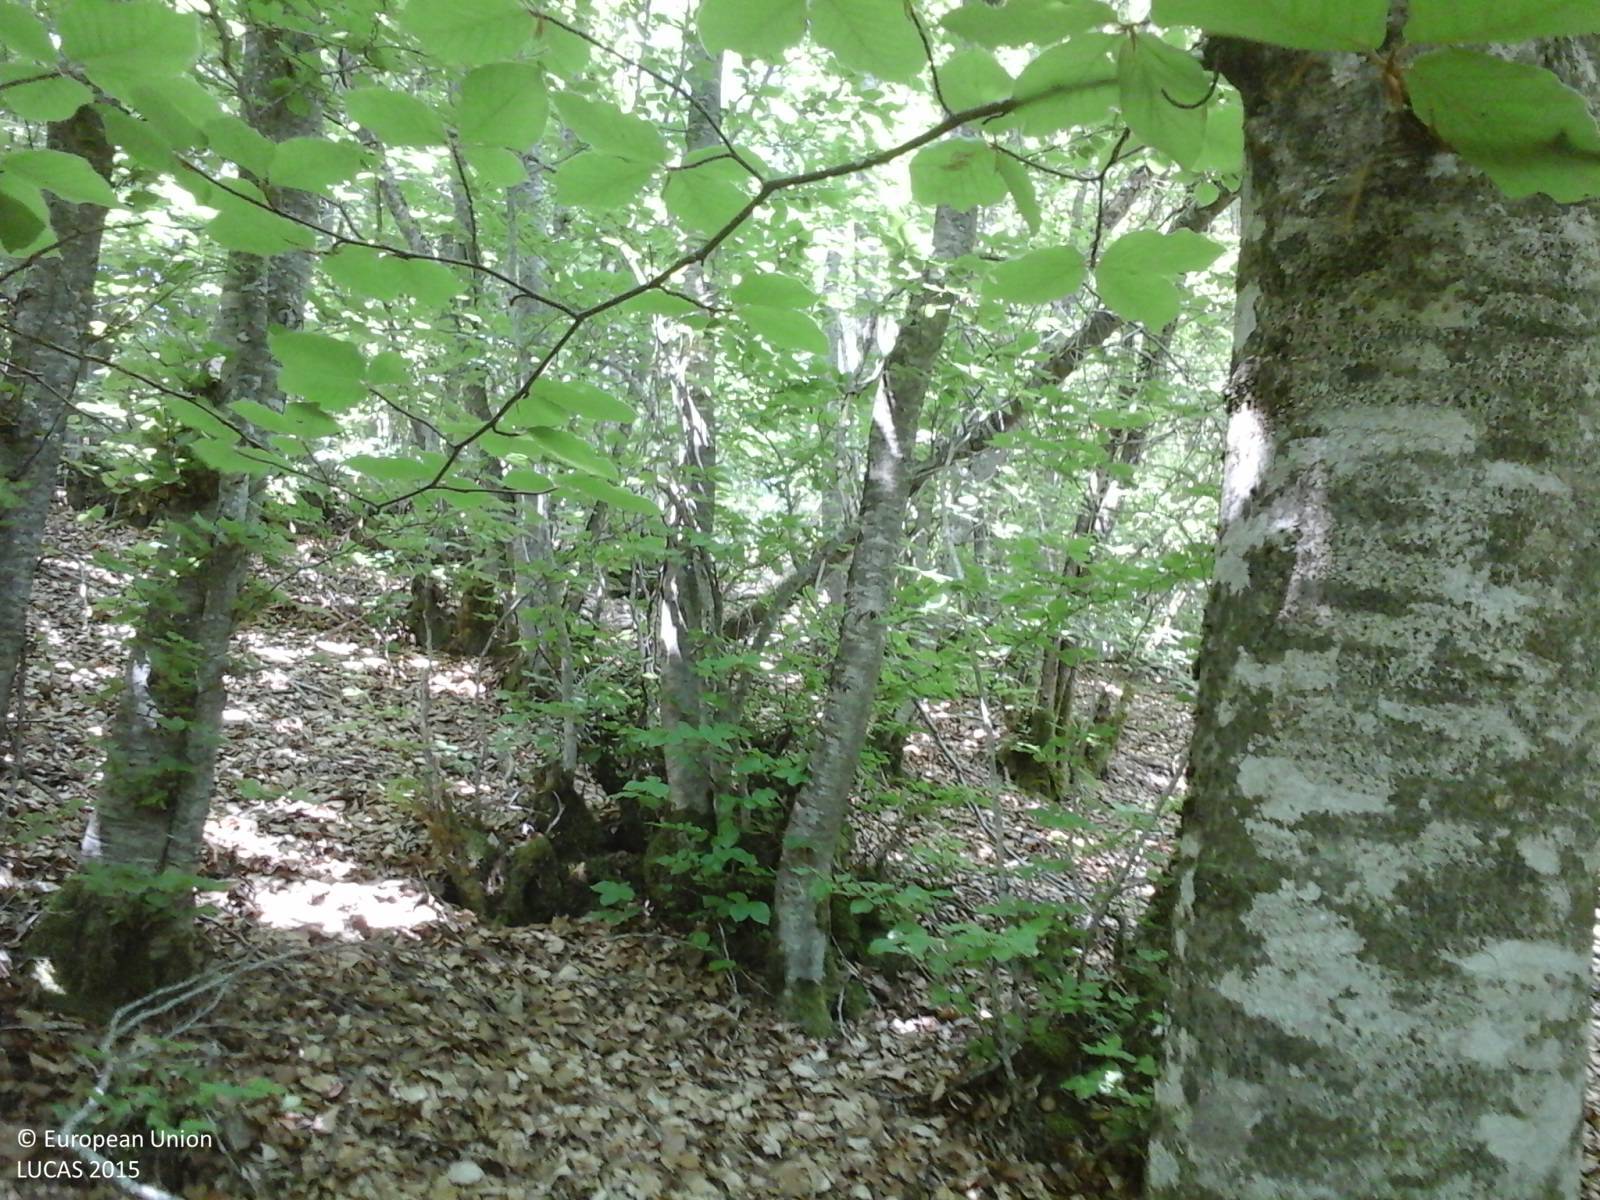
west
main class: Woodland
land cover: Broadleaved woodland
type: mountainous beech forest
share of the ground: > 75 %
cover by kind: broadleaved forest trees 100 %
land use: Forestry
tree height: > 5 m
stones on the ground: < 10 %
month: July
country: IT
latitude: 42.4232
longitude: 13.1861
